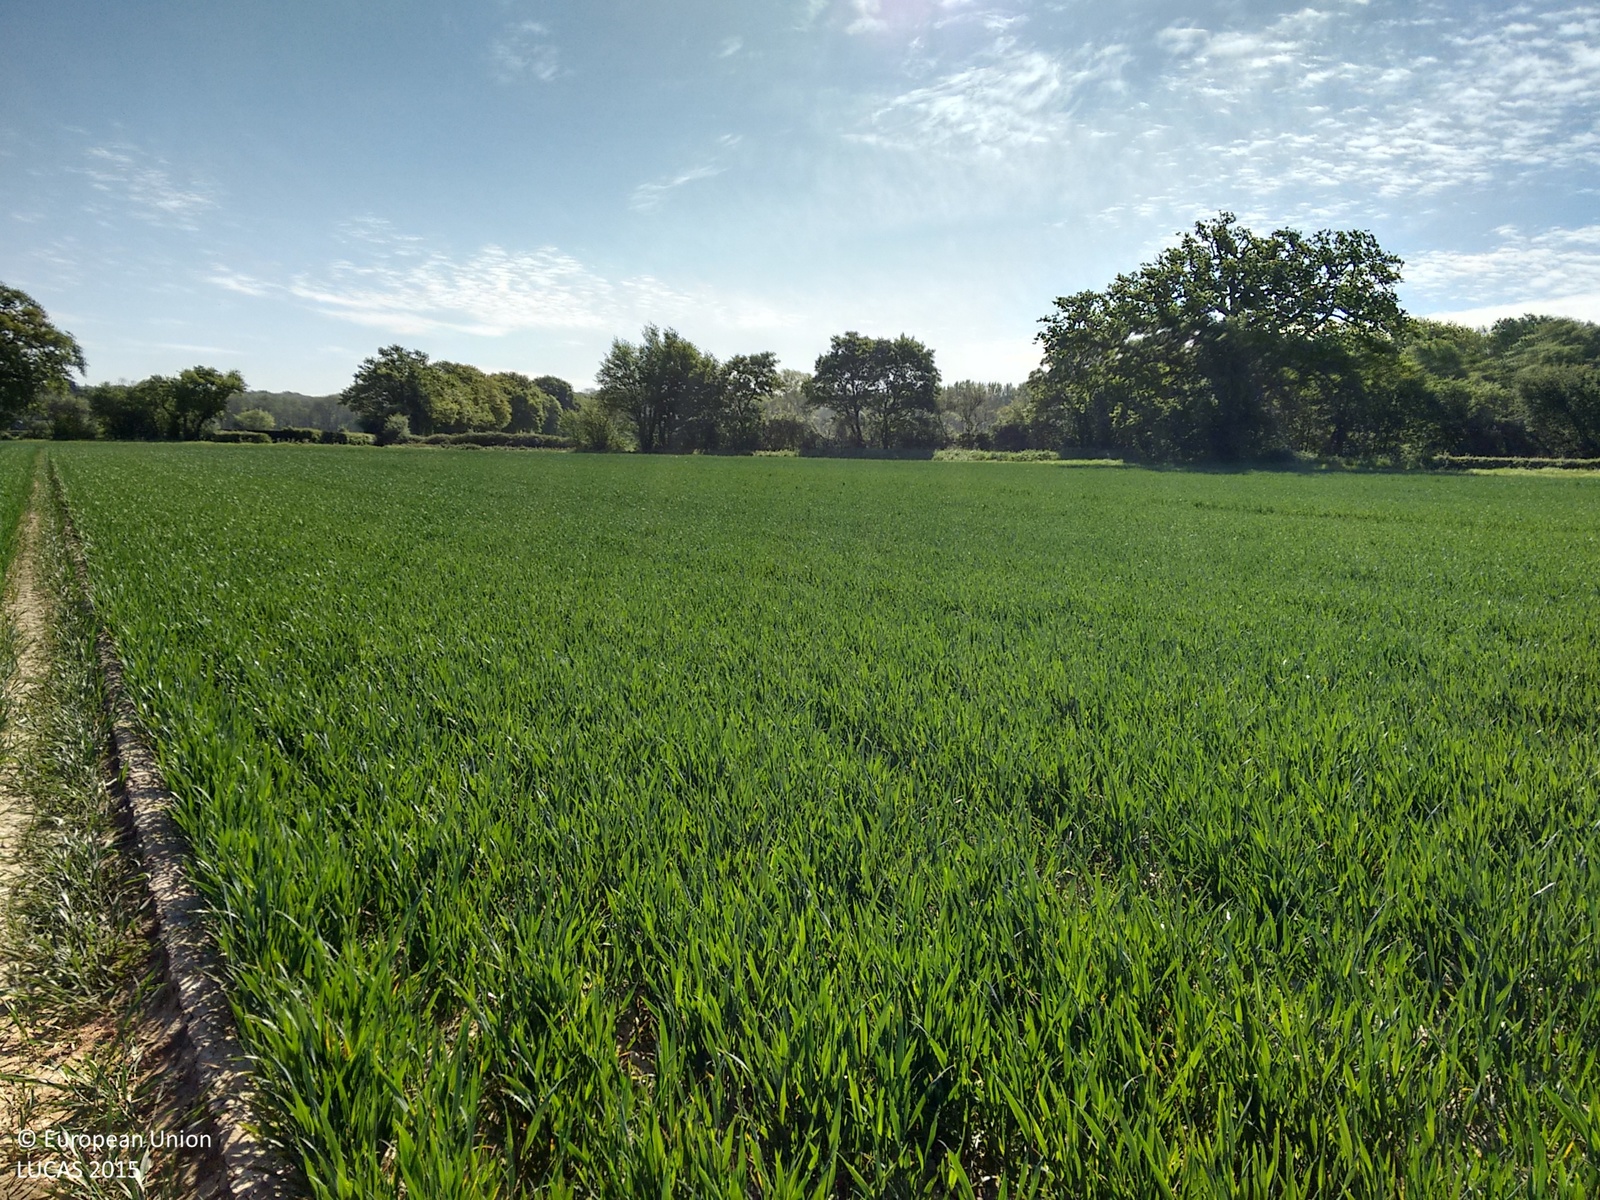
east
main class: Cropland
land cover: Common wheat
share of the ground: 50 - 75 %
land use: Agriculture (excluding fallow land and kitchen gardens)
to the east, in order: Common wheat; Grass margins; Ditches and canals; Grass margins; Paved roads, cycling and walking lanes; Abandoned hedges; Fences; Grass margins; Common wheat
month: May
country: GB
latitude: 51.2826
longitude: -1.0126
